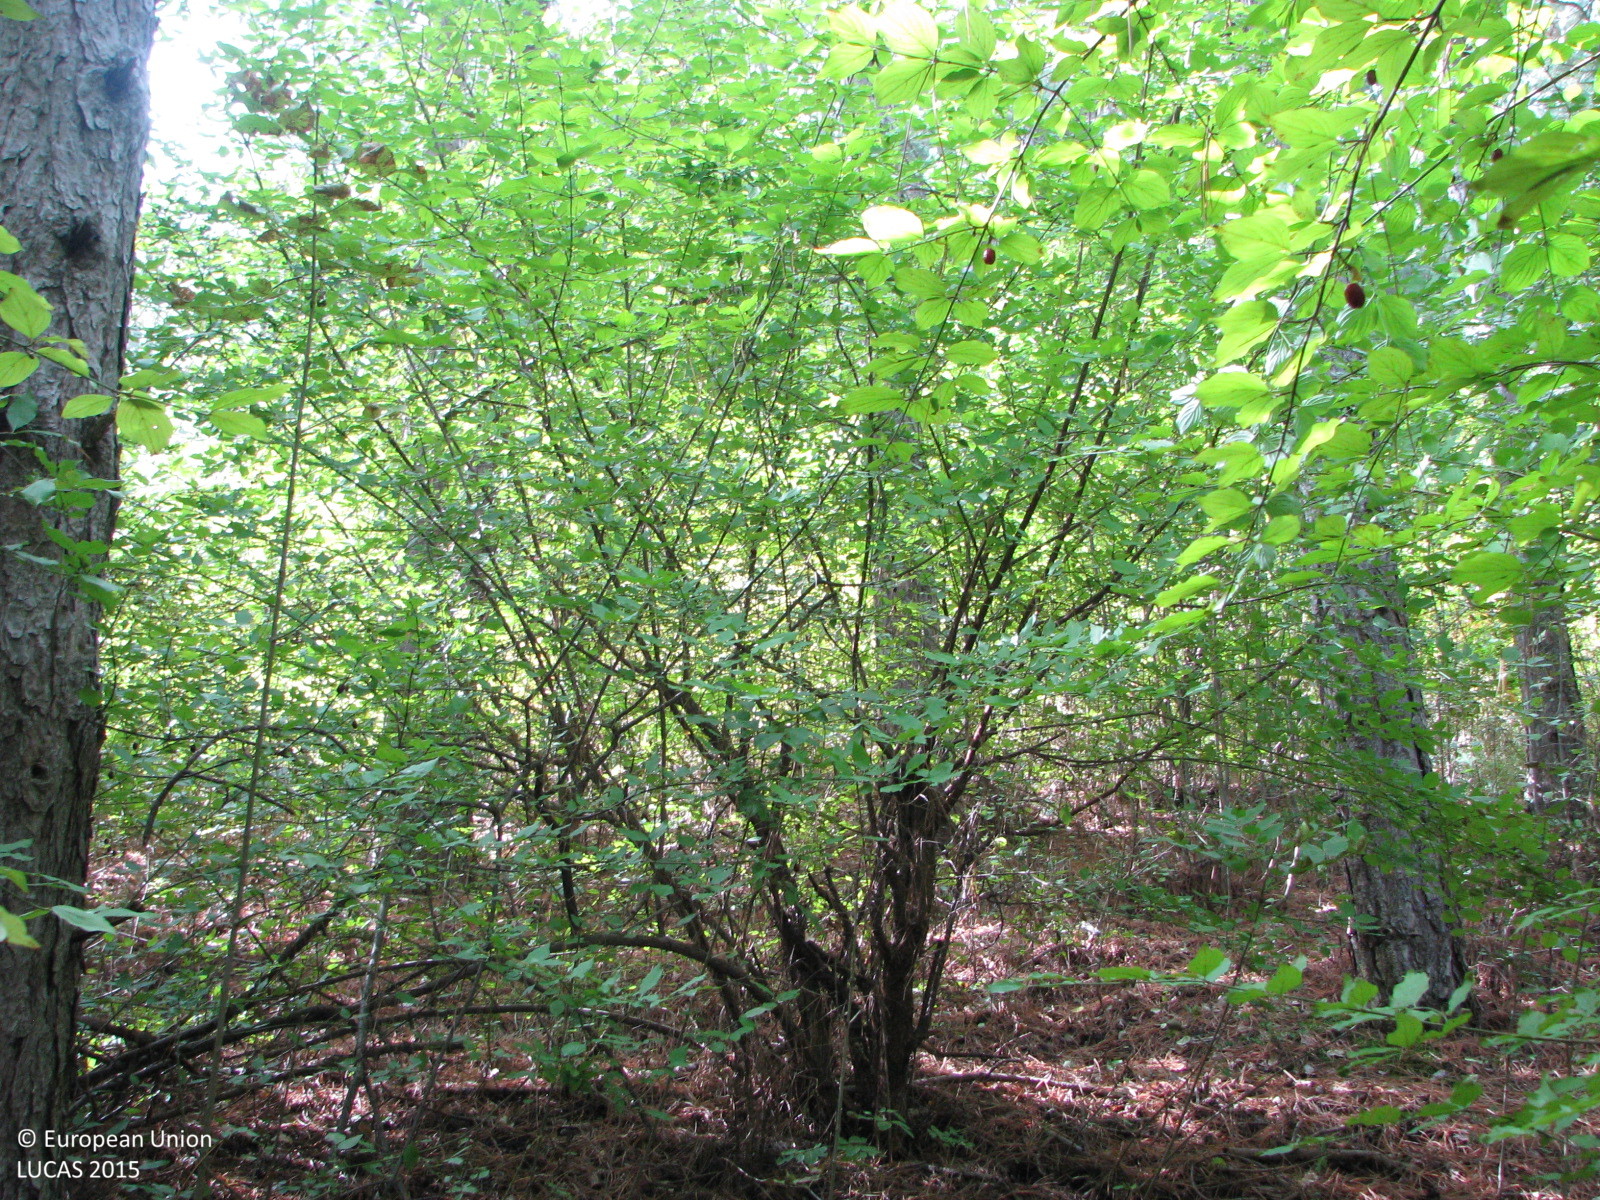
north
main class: Woodland
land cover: Pine dominated mixed woodland
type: hemiboreal forest and nemoral coniferous forest and mixed broadleaved-coniferous forest
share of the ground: > 75 %
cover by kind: coniferous forest trees 60 %, broadleaved forest trees 20 %, shrubs 10 %, unconsolidated bare surface 10 %
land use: Forestry
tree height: > 5 m
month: September
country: BG
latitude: 42.6997
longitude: 26.3142
